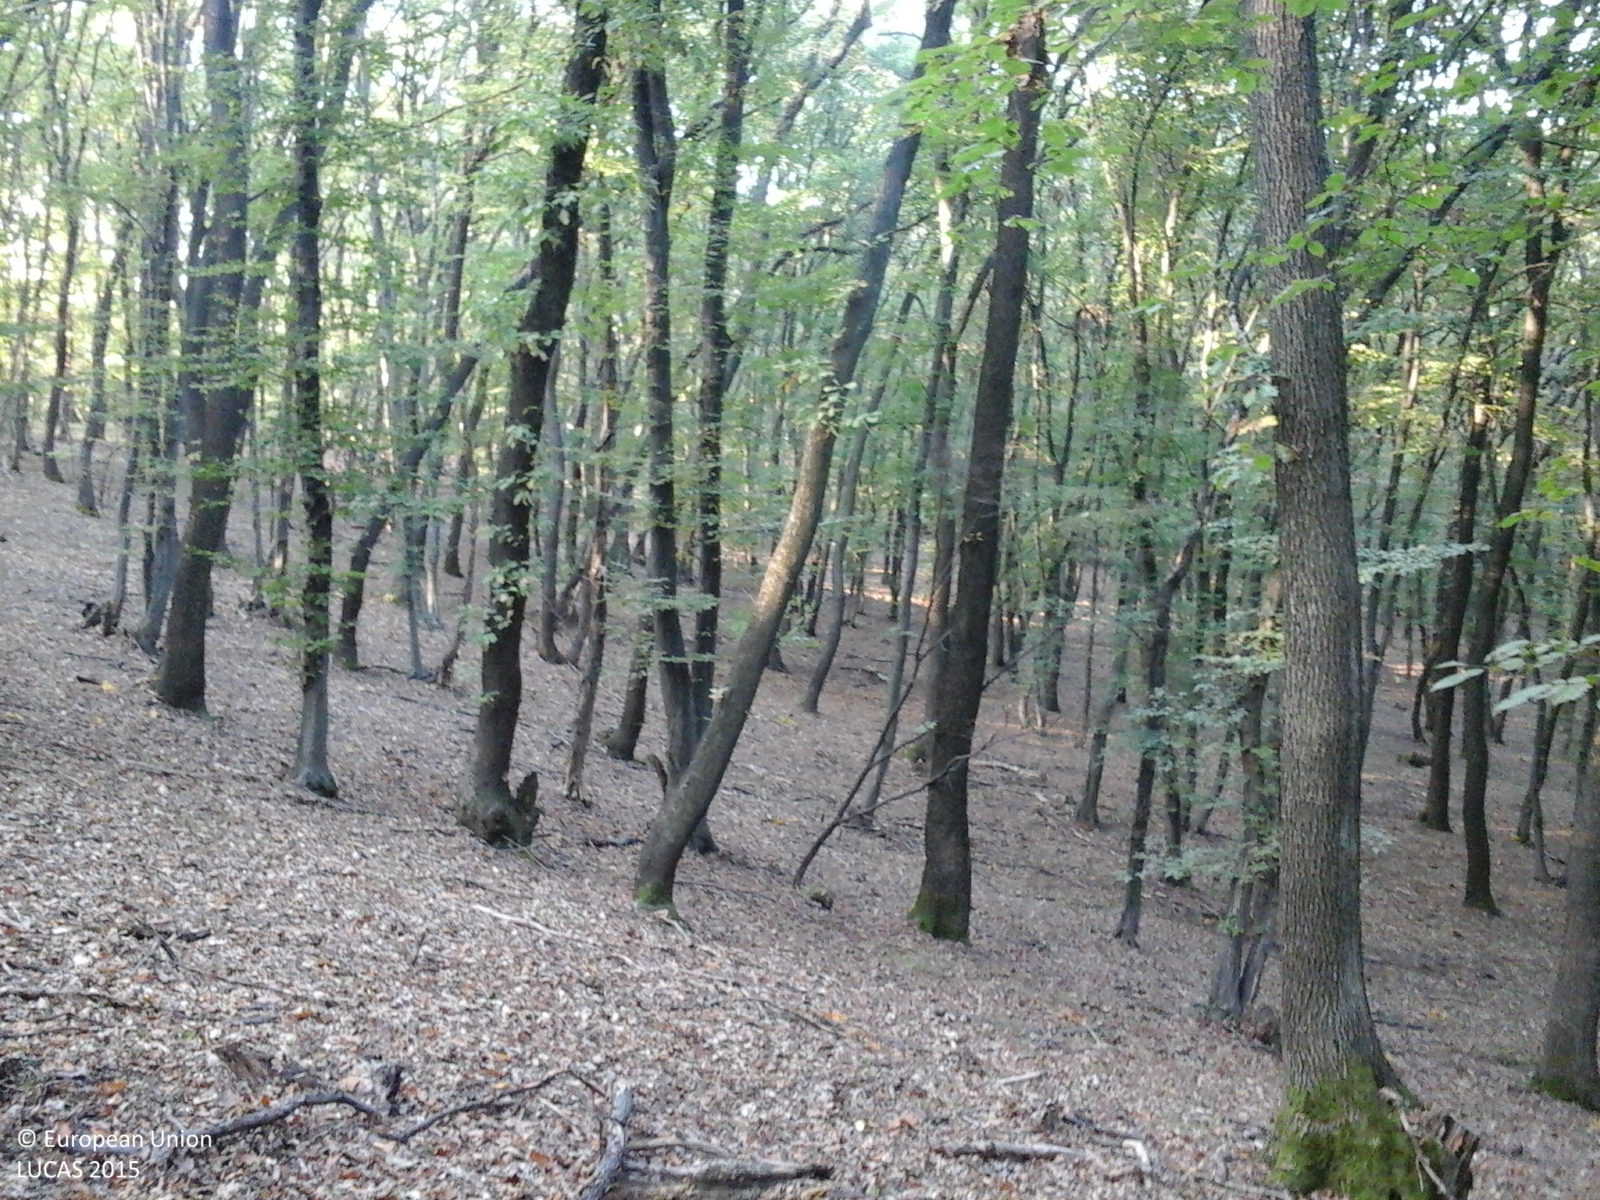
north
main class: Woodland
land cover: Broadleaved woodland
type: acidophilous oak and oak-birch forest
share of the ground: > 75 %
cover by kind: broadleaved forest trees 100 %
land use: Forestry
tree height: > 5 m
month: October
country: RO
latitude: 46.1821
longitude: 24.2127
